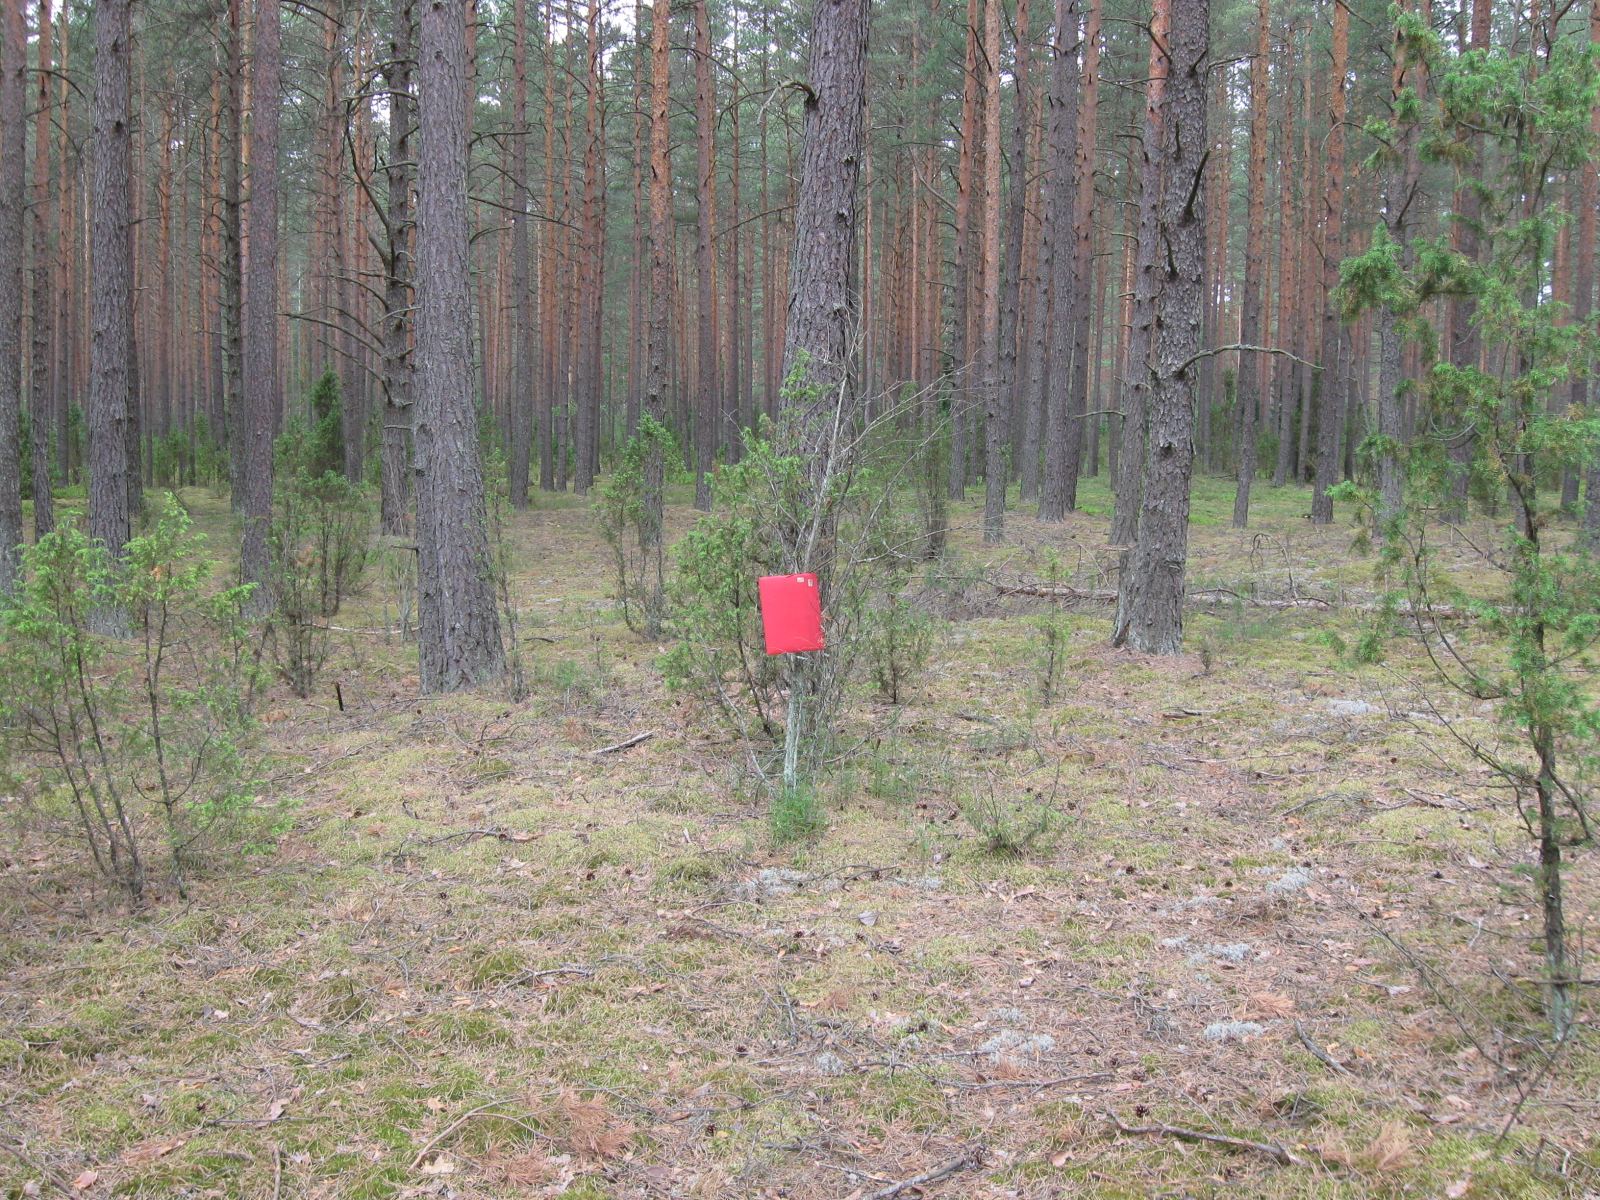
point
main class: Woodland
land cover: Pine dominated coniferous woodland
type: hemiboreal forest and nemoral coniferous forest and mixed broadleaved-coniferous forest
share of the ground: > 75 %
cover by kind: coniferous forest trees 95 %, lichens and mosses 5 %
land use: Forestry
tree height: > 5 m
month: July
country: LT
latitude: 54.1775
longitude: 24.2704
